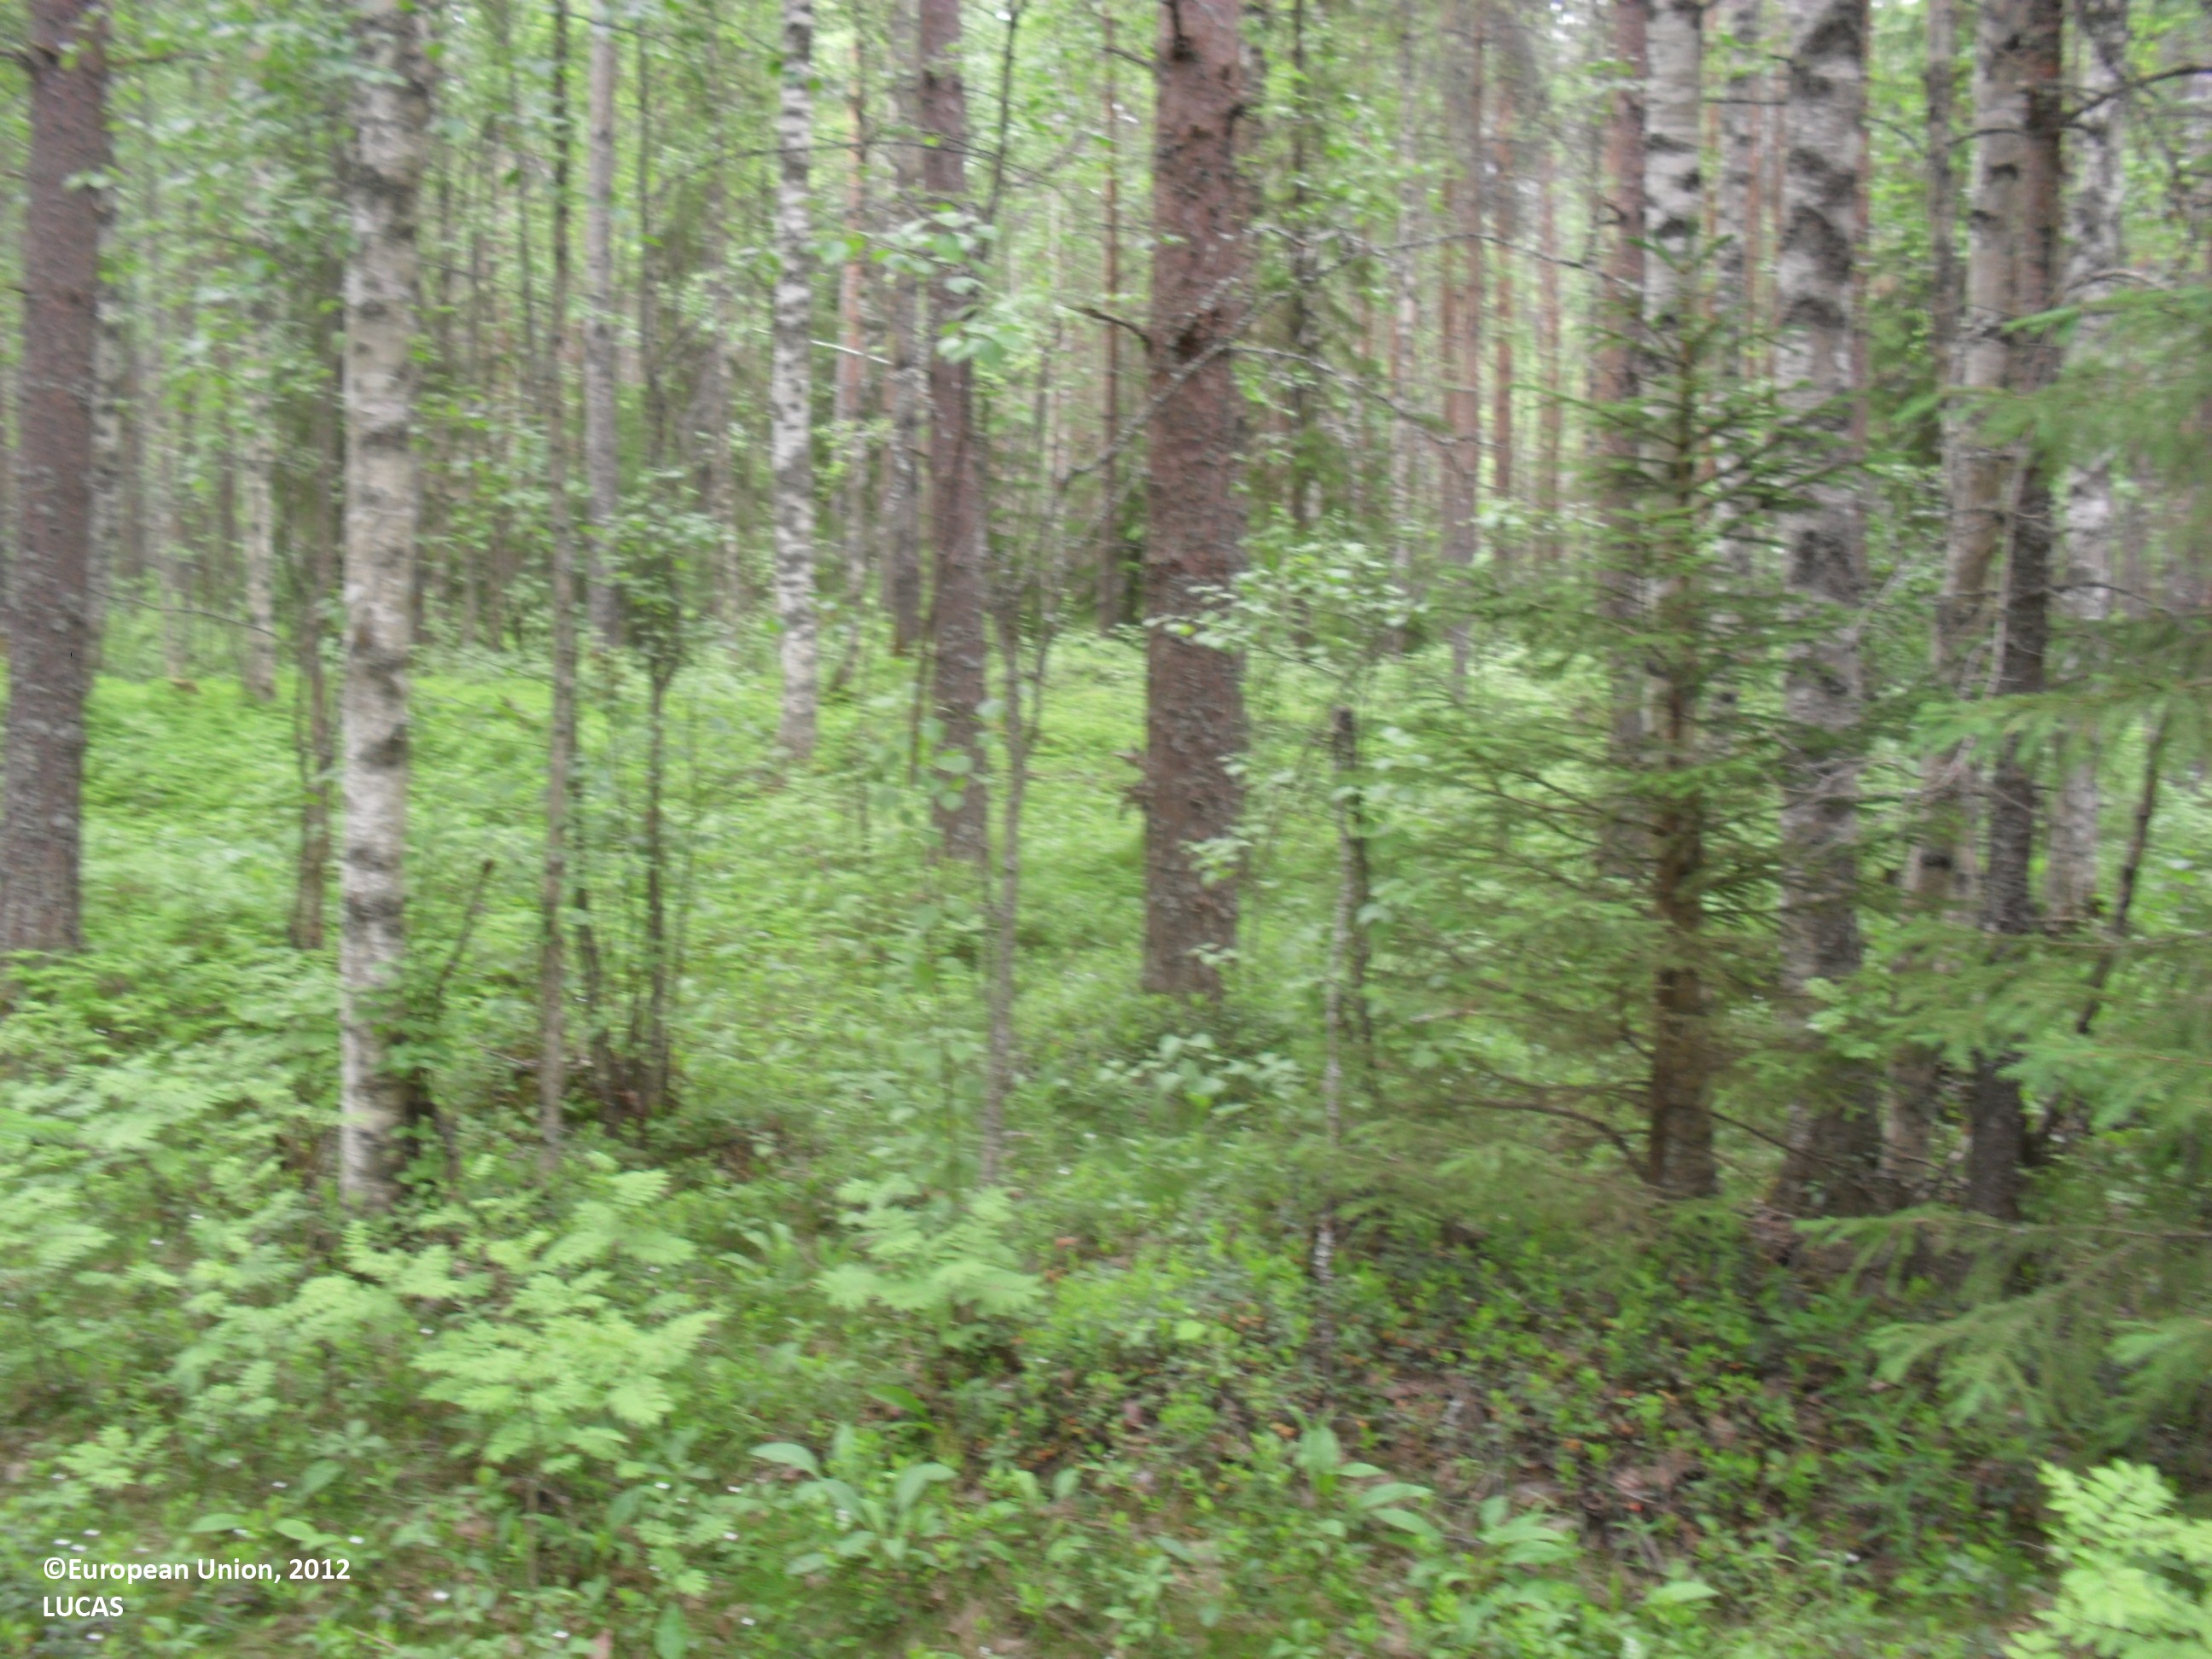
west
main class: Woodland
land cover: Other mixed woodland
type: boreal forest
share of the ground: 25 - 50 %
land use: Forestry
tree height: > 5 m
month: June
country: FI
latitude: 63.4234
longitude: 23.1800
